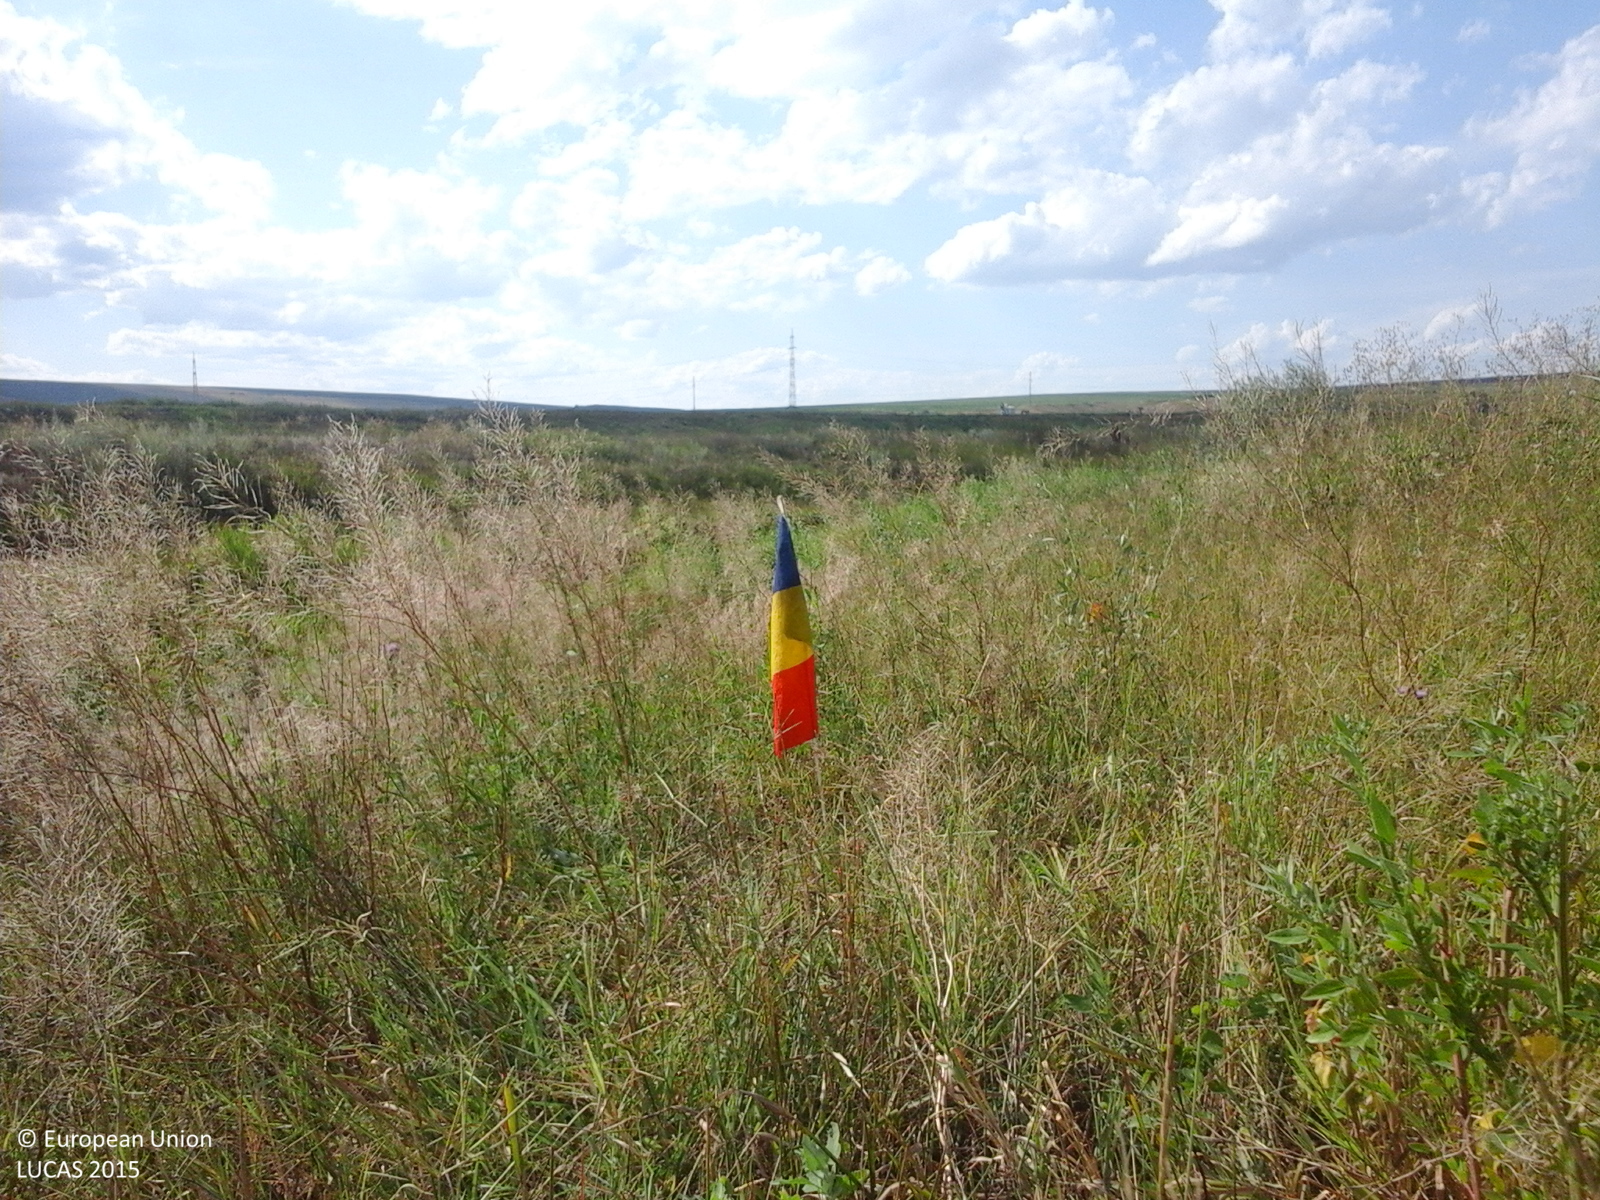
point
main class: Grassland
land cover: Grassland without tree/shrub cover
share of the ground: > 75 %
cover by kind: herbaceous plants 100 %
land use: Agriculture (excluding fallow land and kitchen gardens)
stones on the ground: < 10 %
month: July
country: RO
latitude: 46.3396
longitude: 27.7742
